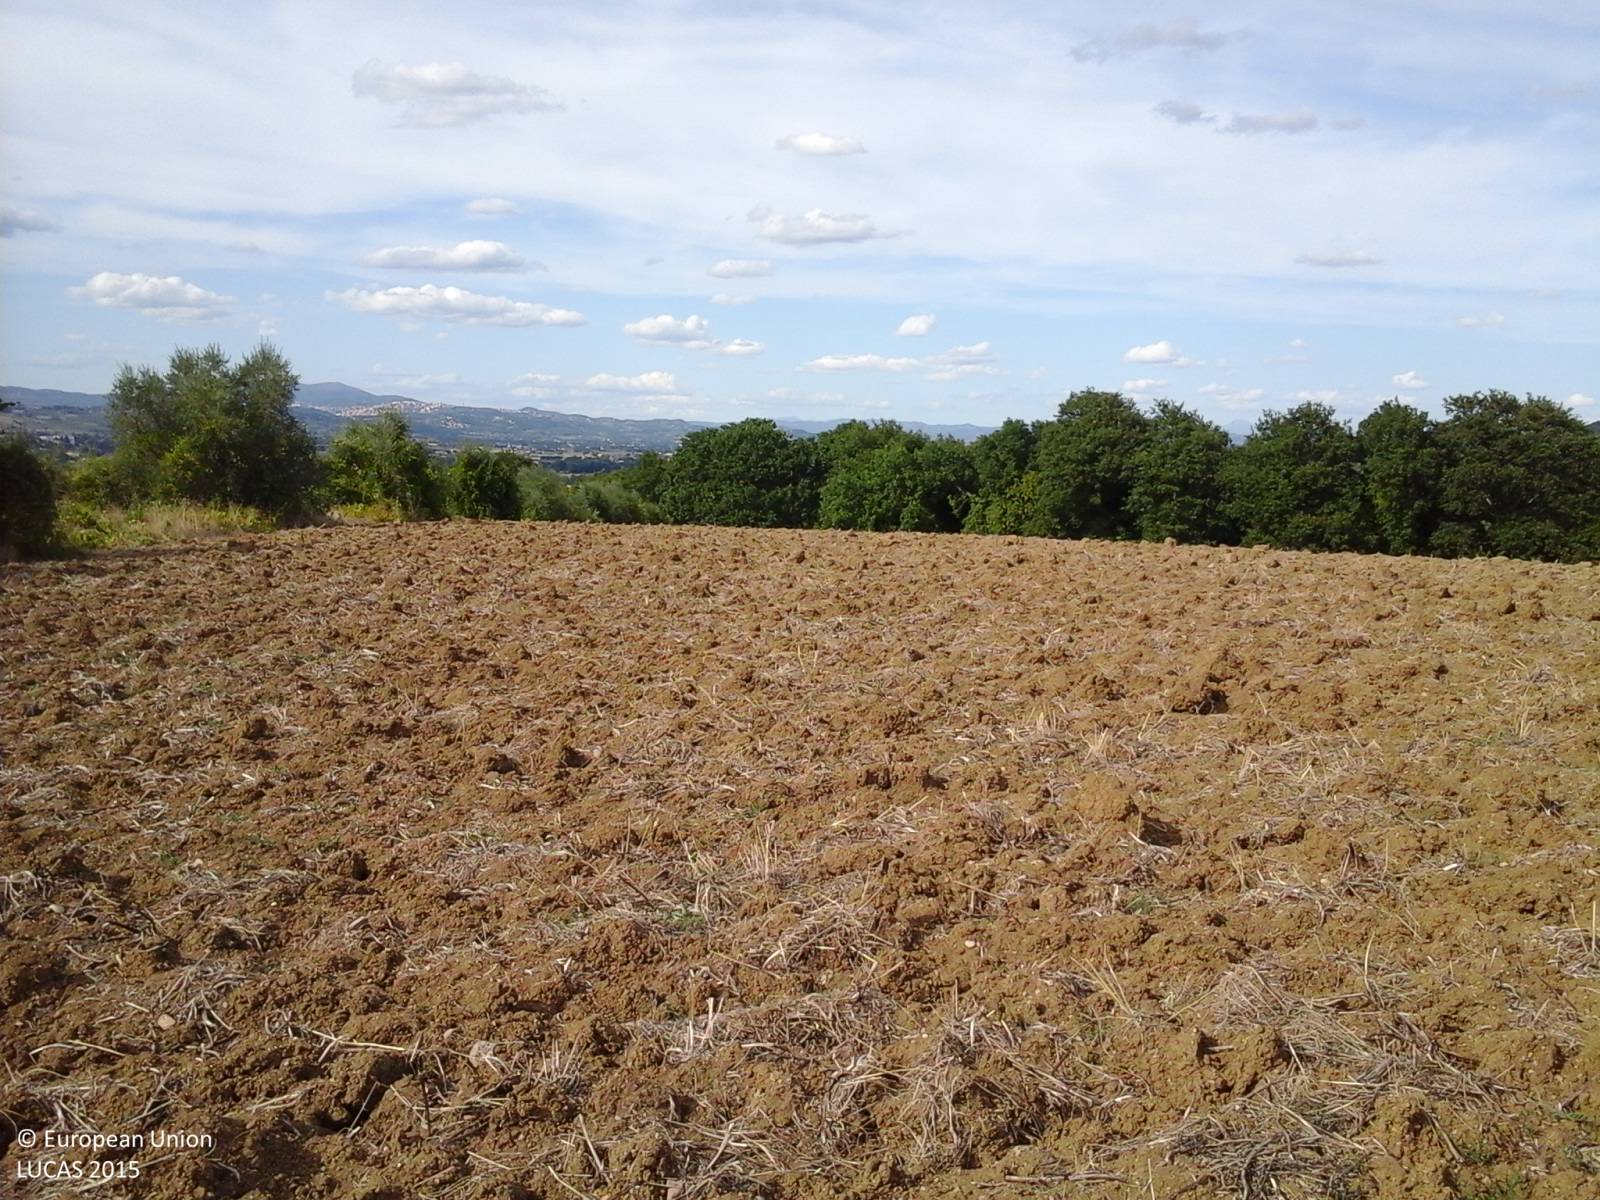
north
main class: Cropland
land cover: Dry pulses
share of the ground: < 10 %
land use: Agriculture (excluding fallow land and kitchen gardens)
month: September
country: IT
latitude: 42.9686
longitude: 12.4081
